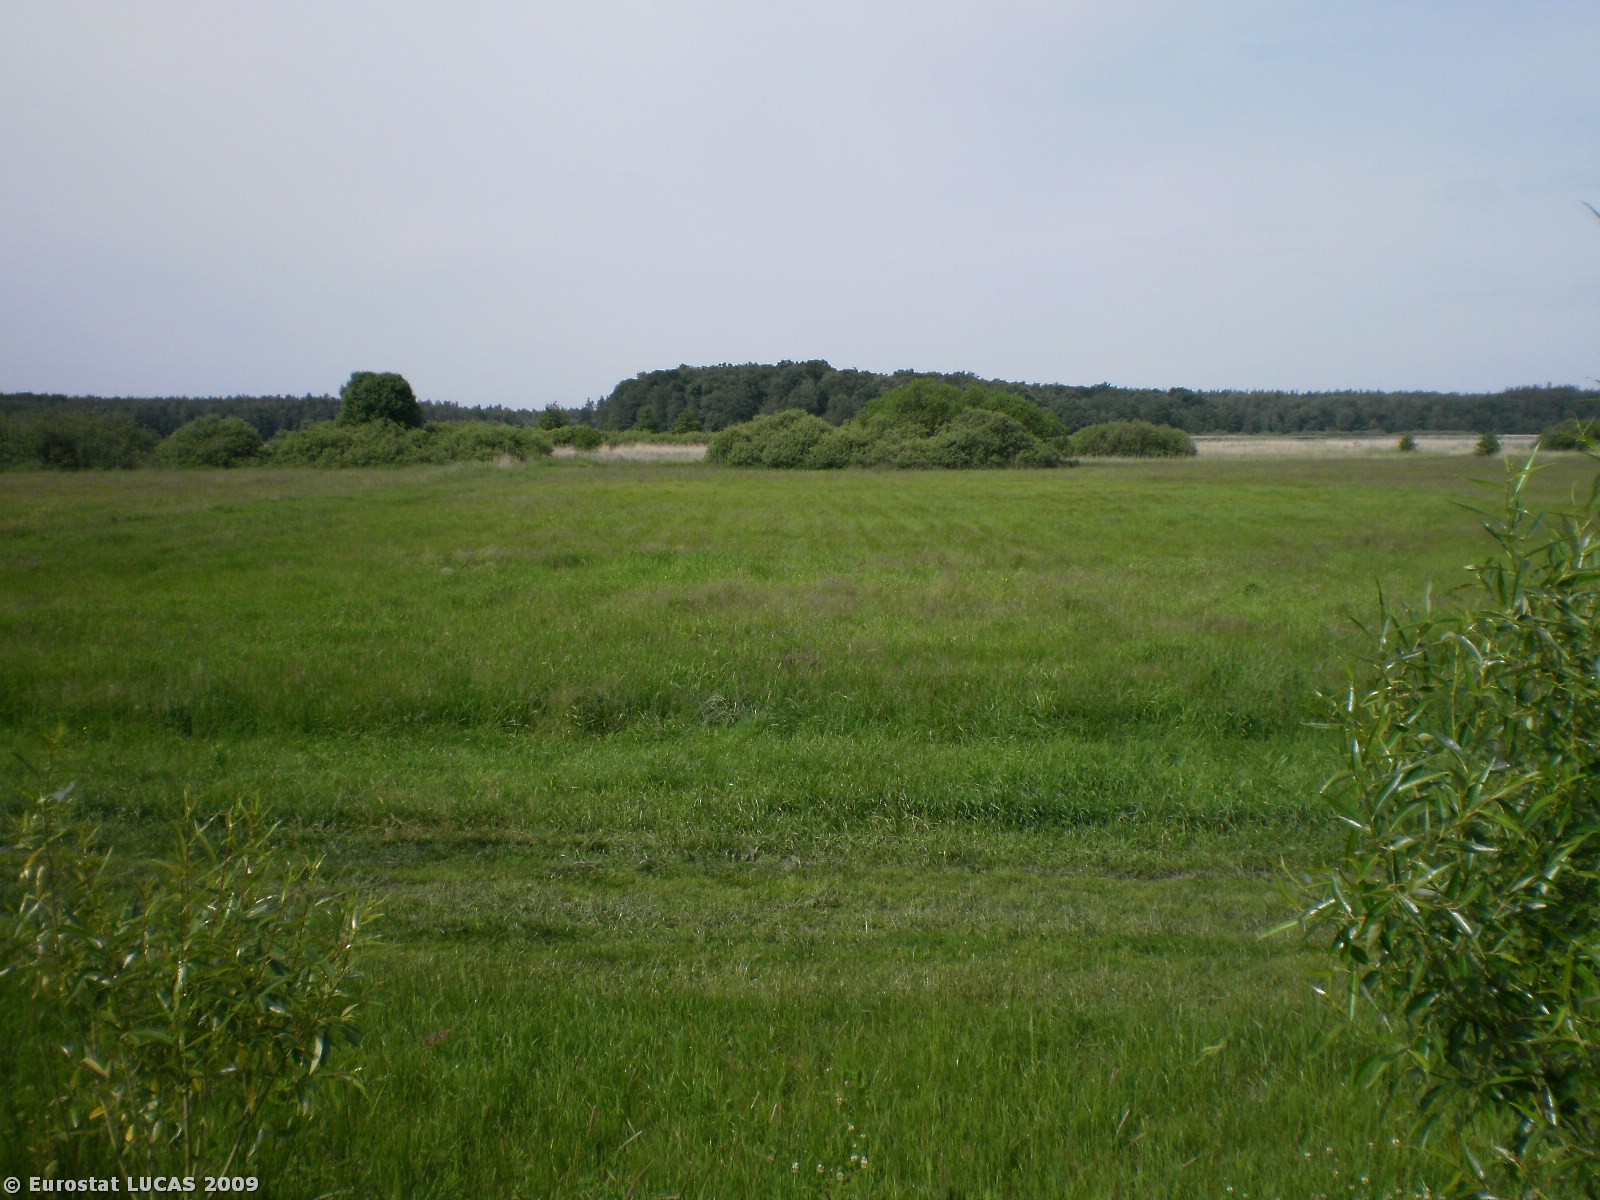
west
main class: Cropland
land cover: Rye
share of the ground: > 75 %
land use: Agriculture (excluding fallow land and kitchen gardens)
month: June
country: PL
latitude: 53.7179
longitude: 19.9258
